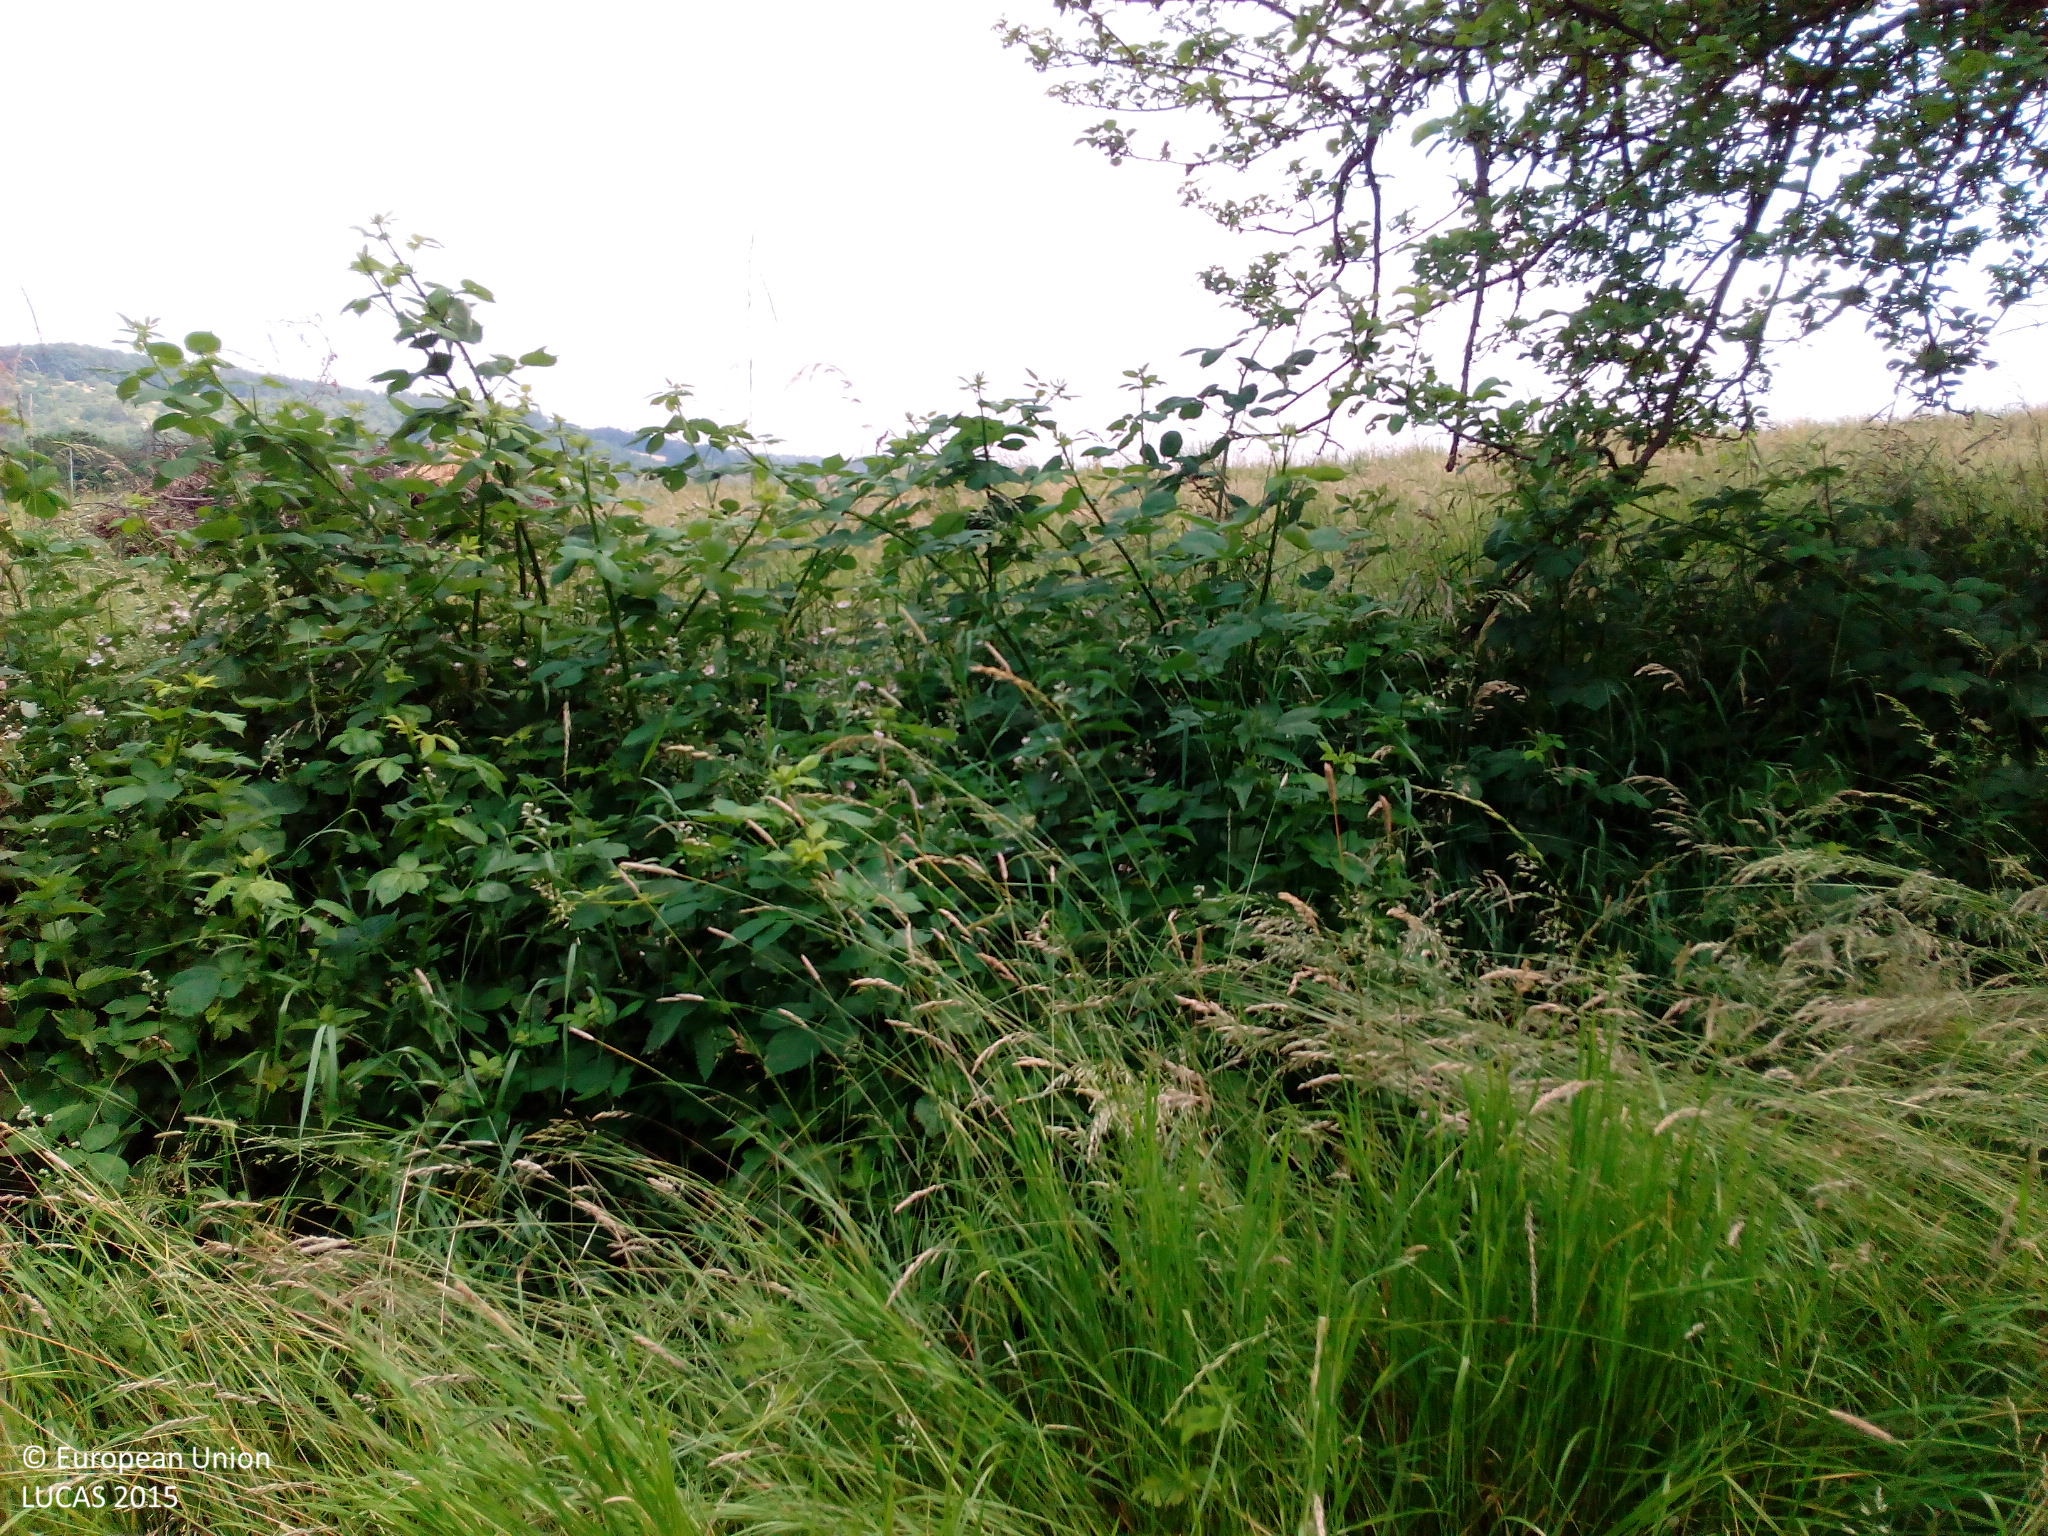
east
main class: Cropland
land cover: Apple fruit
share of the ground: 50 - 75 %
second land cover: Grassland without tree/shrub cover
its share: 50 - 75 %
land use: Agriculture (excluding fallow land and kitchen gardens)
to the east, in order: Apple fruit; Grassland without tree/shrub cover; Fences; Grass margins; Ditches and canals; Grassland without tree/shrub cover; Tracks; Grassland with sparse tree/shrub cover; Common wheat; Oats; Grass margins; Oats
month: June
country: DE
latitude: 48.8697
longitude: 9.4140
